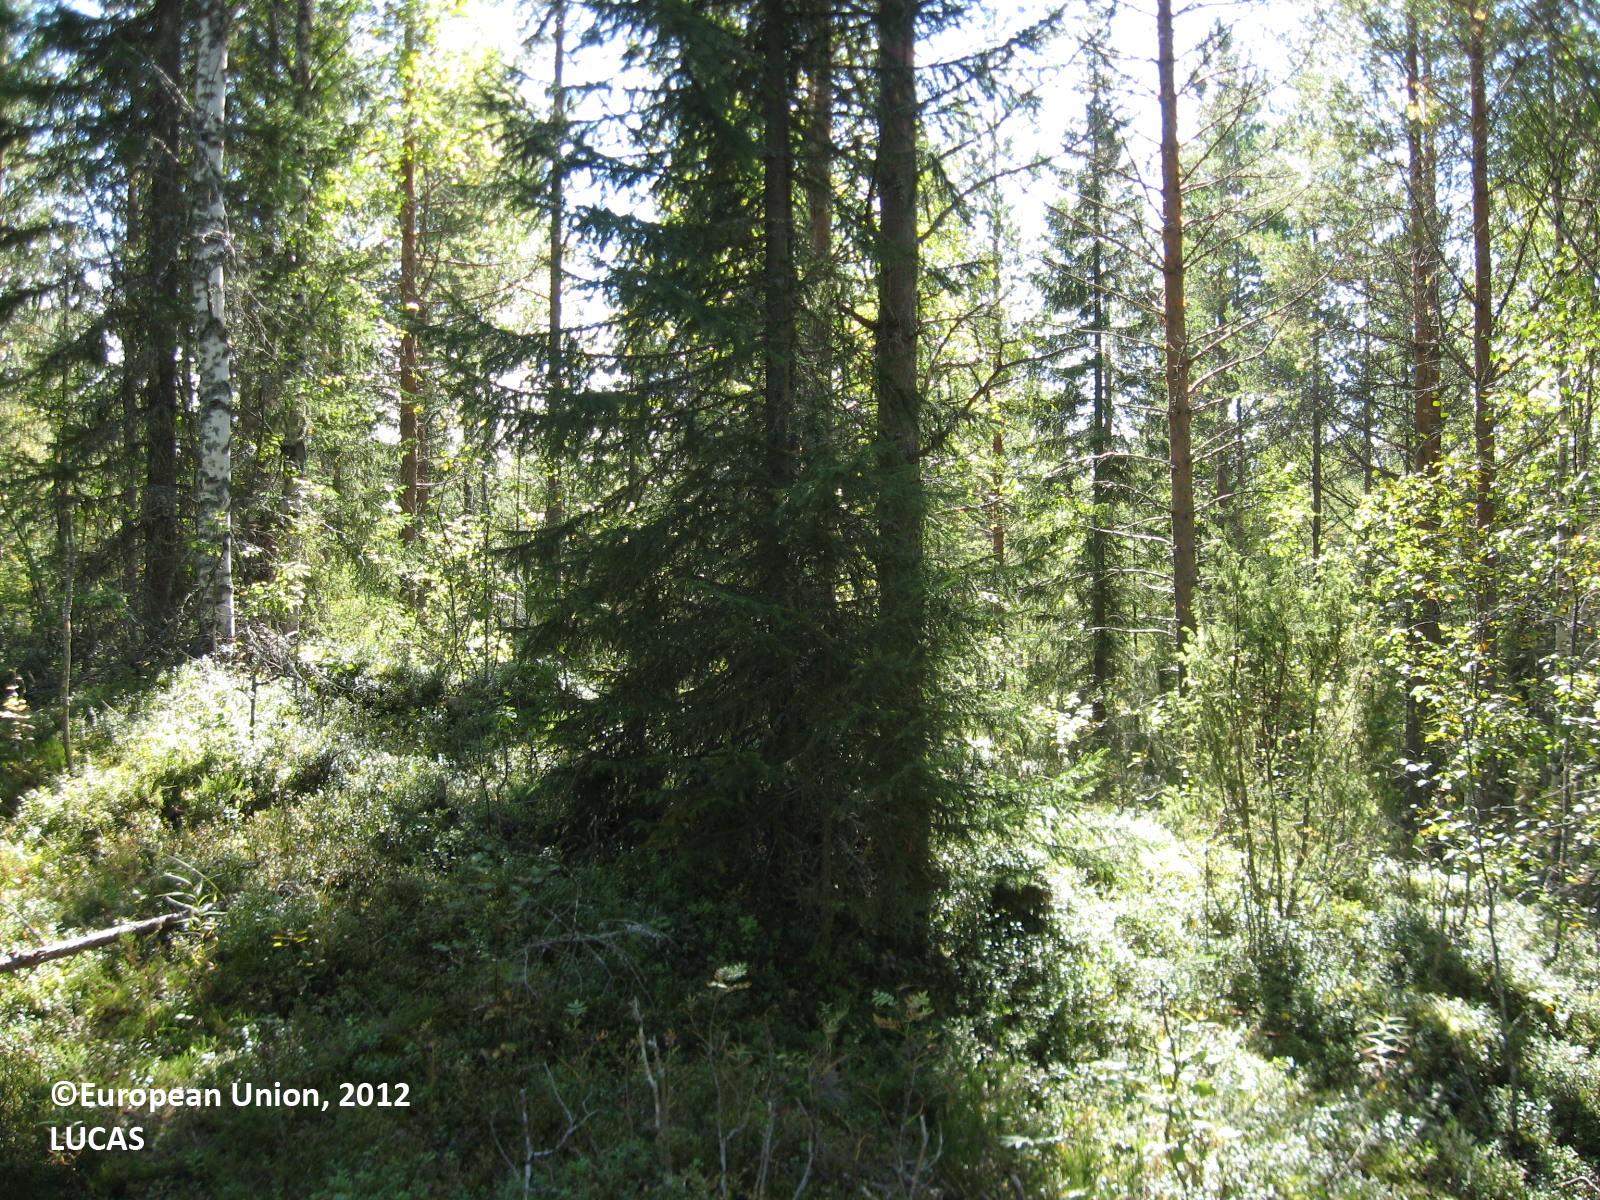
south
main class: Woodland
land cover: Pine dominated mixed woodland
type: boreal forest
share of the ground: > 75 %
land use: Forestry
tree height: > 5 m
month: August
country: FI
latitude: 63.8378
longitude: 29.3877
